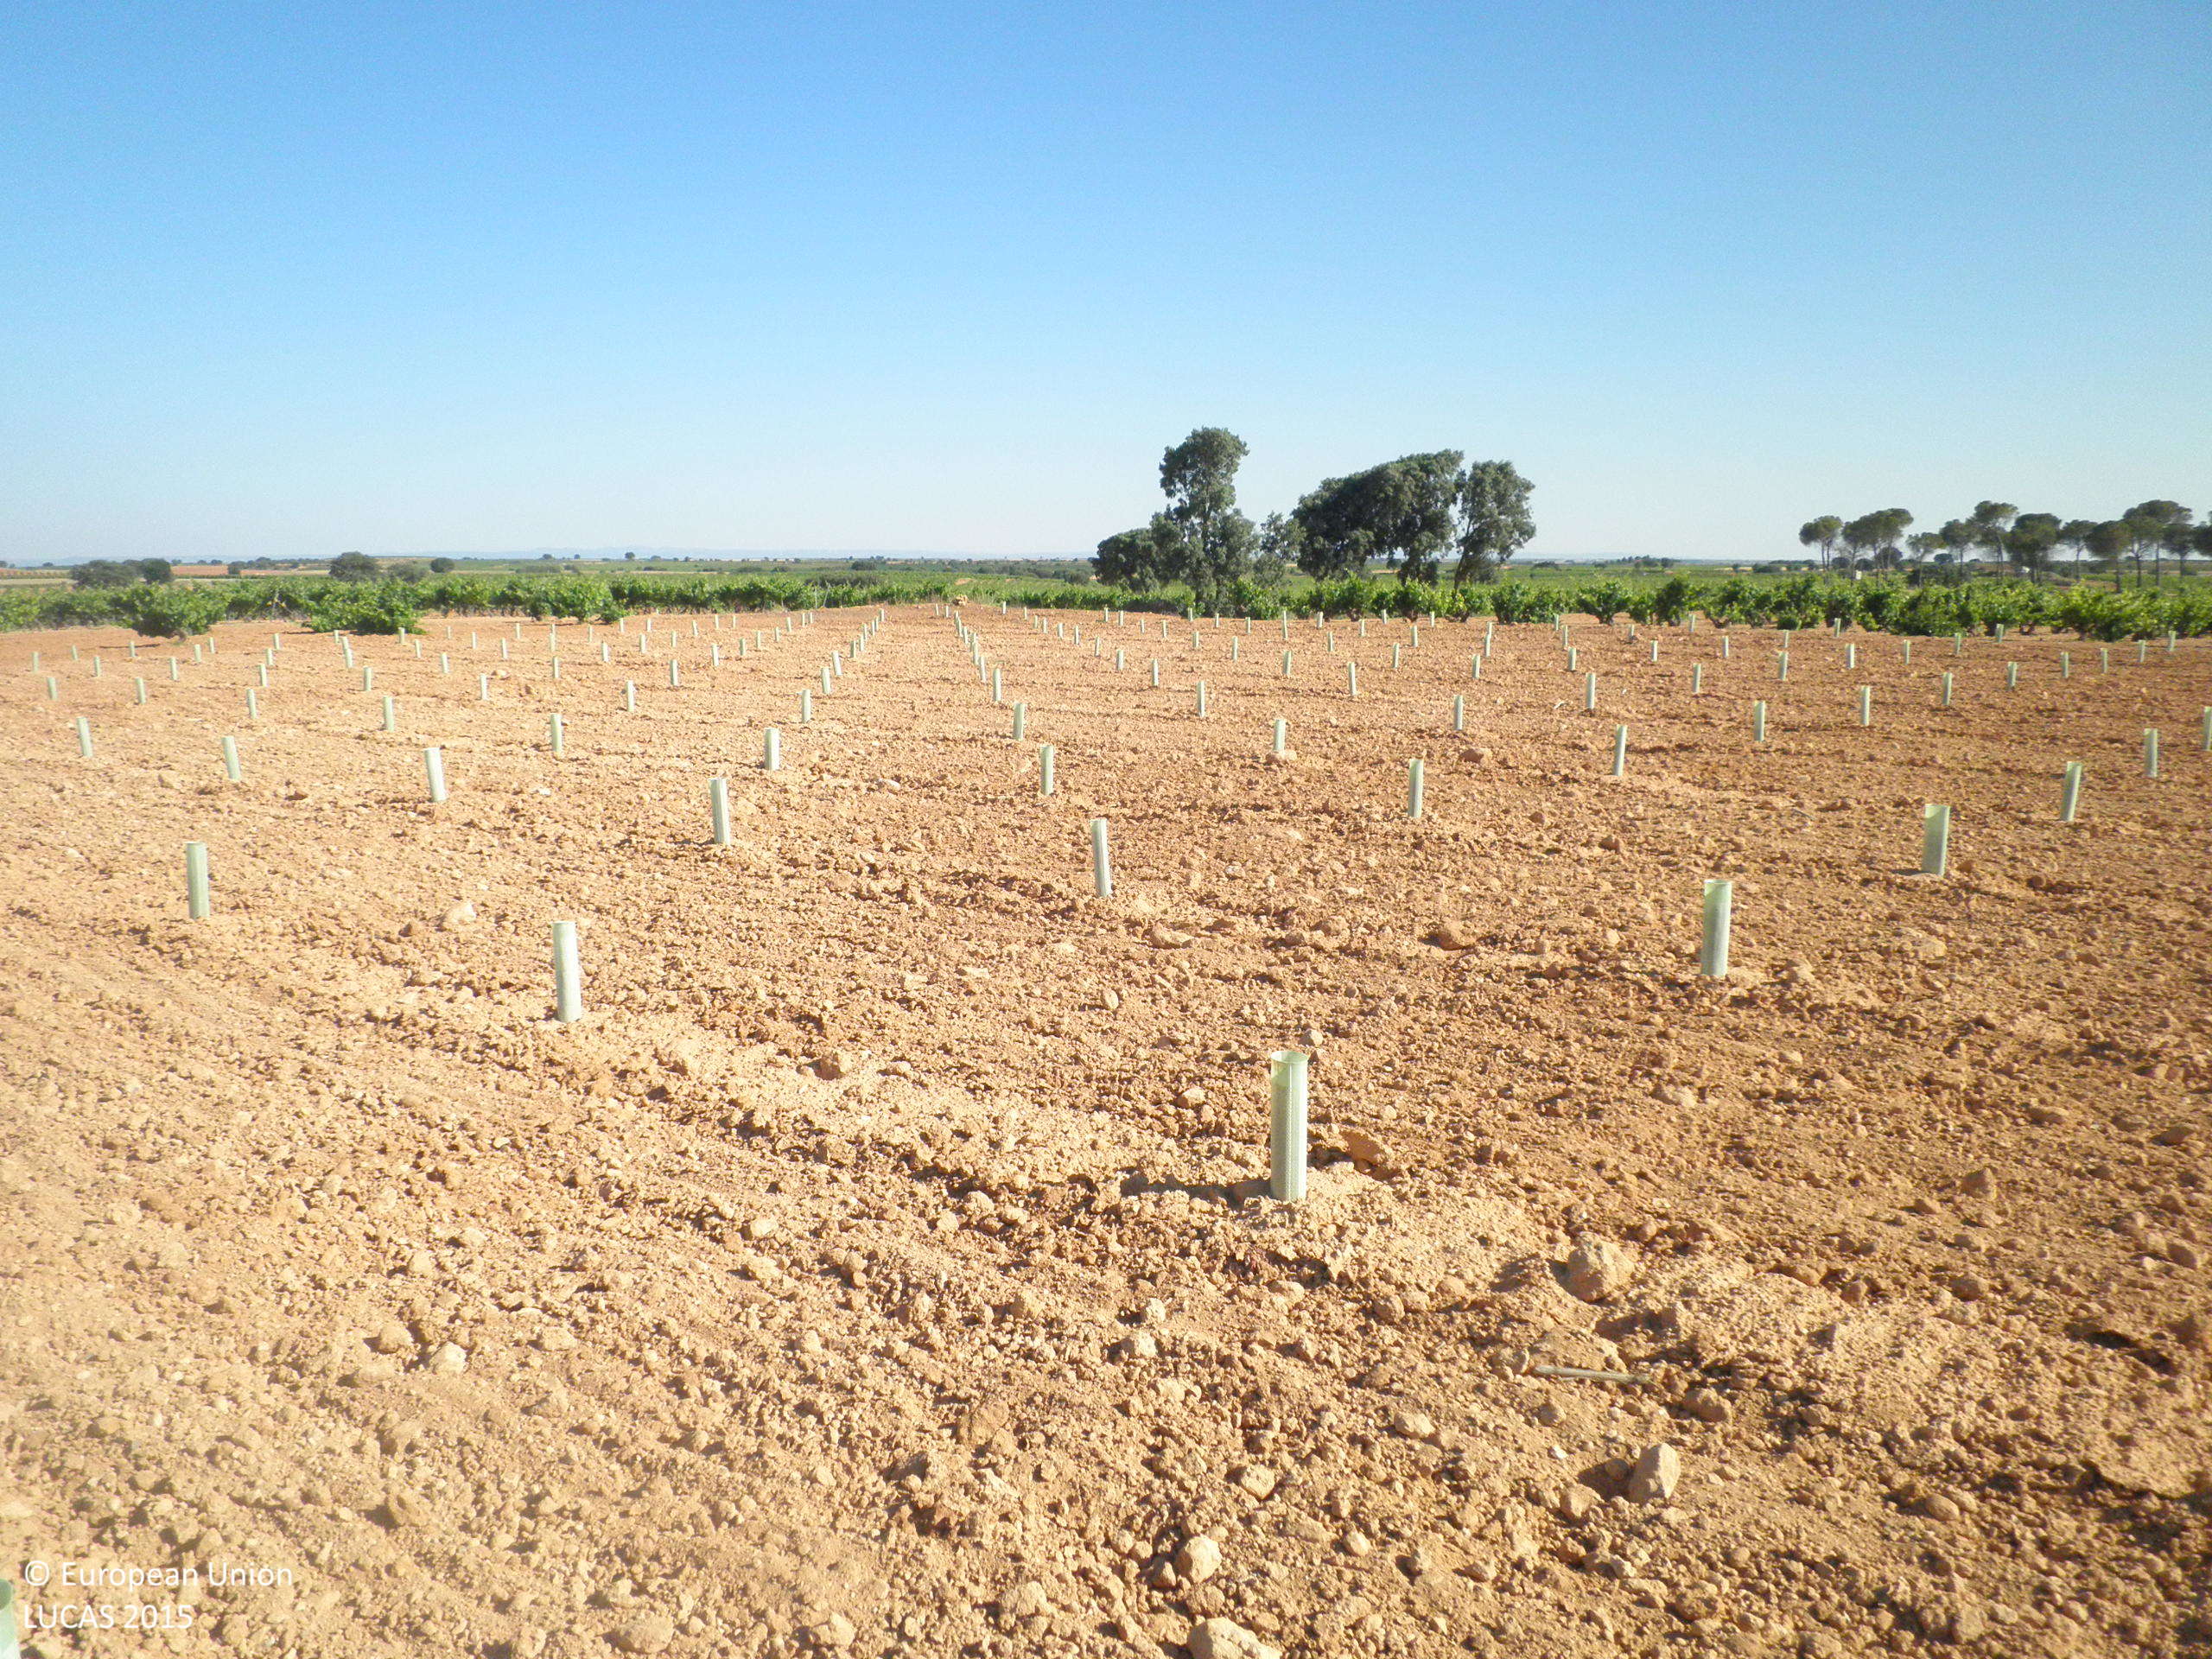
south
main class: Cropland
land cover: Vineyards
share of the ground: < 10 %
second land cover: Other bare soil
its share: > 75 %
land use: Agriculture (excluding fallow land and kitchen gardens)
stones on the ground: < 10 %
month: June
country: ES
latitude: 39.4033
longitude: -1.6751
